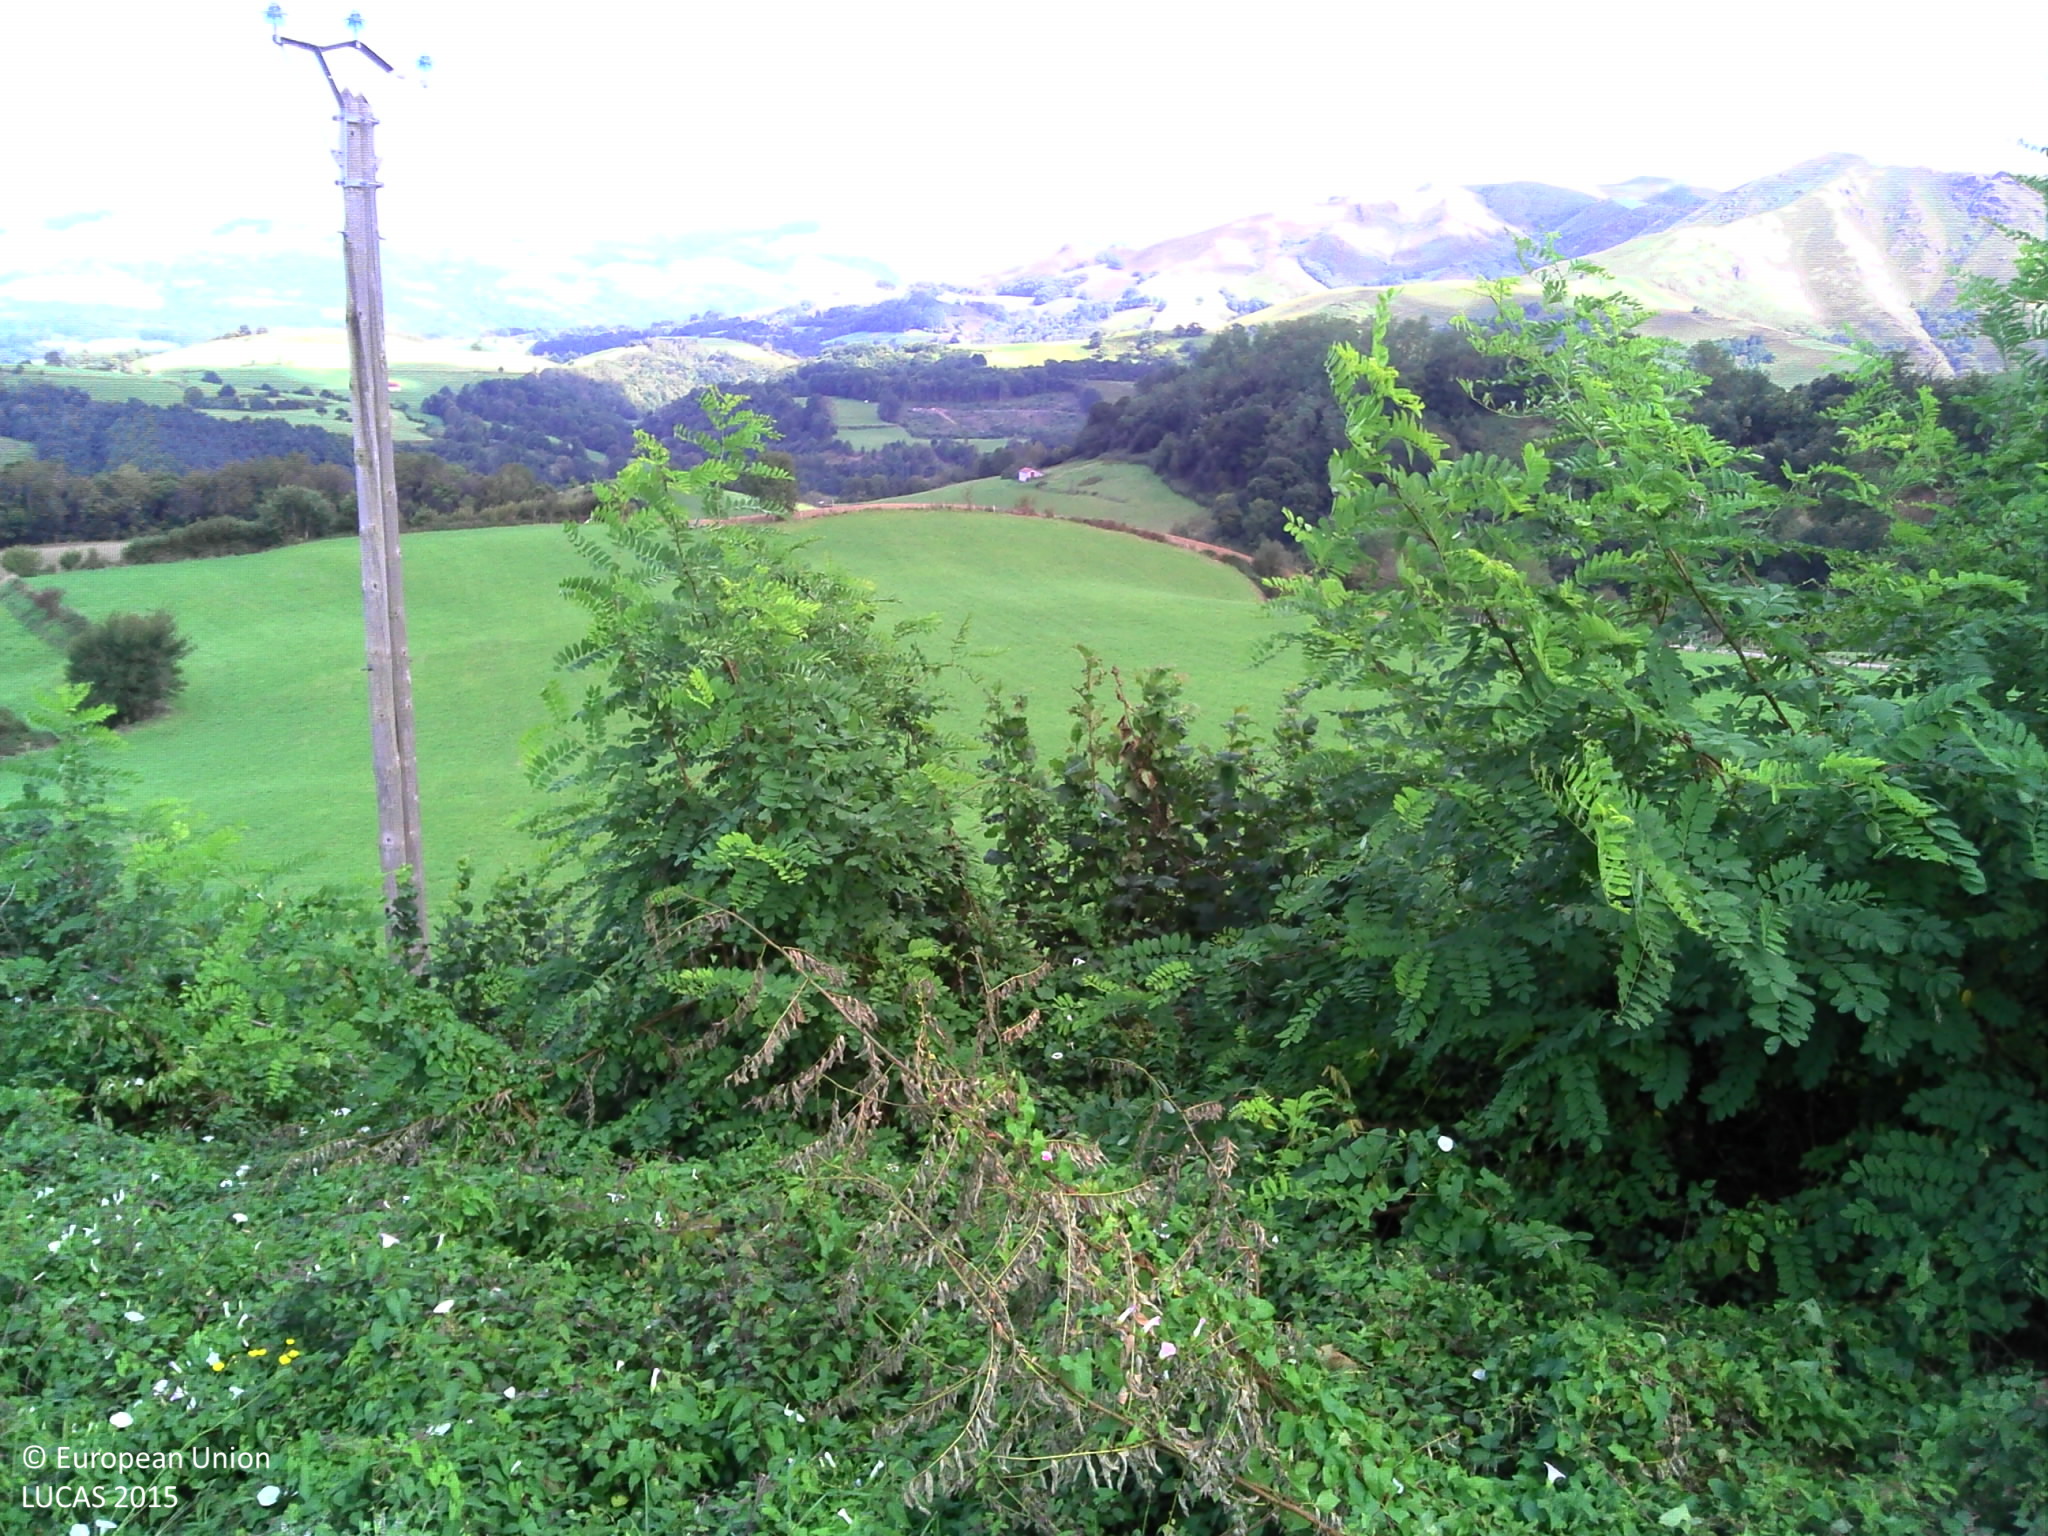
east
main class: Grassland
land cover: Grassland without tree/shrub cover
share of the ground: > 75 %
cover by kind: herbaceous plants 100 %
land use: Agriculture (excluding fallow land and kitchen gardens)
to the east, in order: Grassland without tree/shrub cover; Spontaneously vegetated surfaces; Broadleaved woodland; Tracks; Fences; Electric lines; Grassland without tree/shrub cover
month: September
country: FR
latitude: 43.1375
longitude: -1.2378
